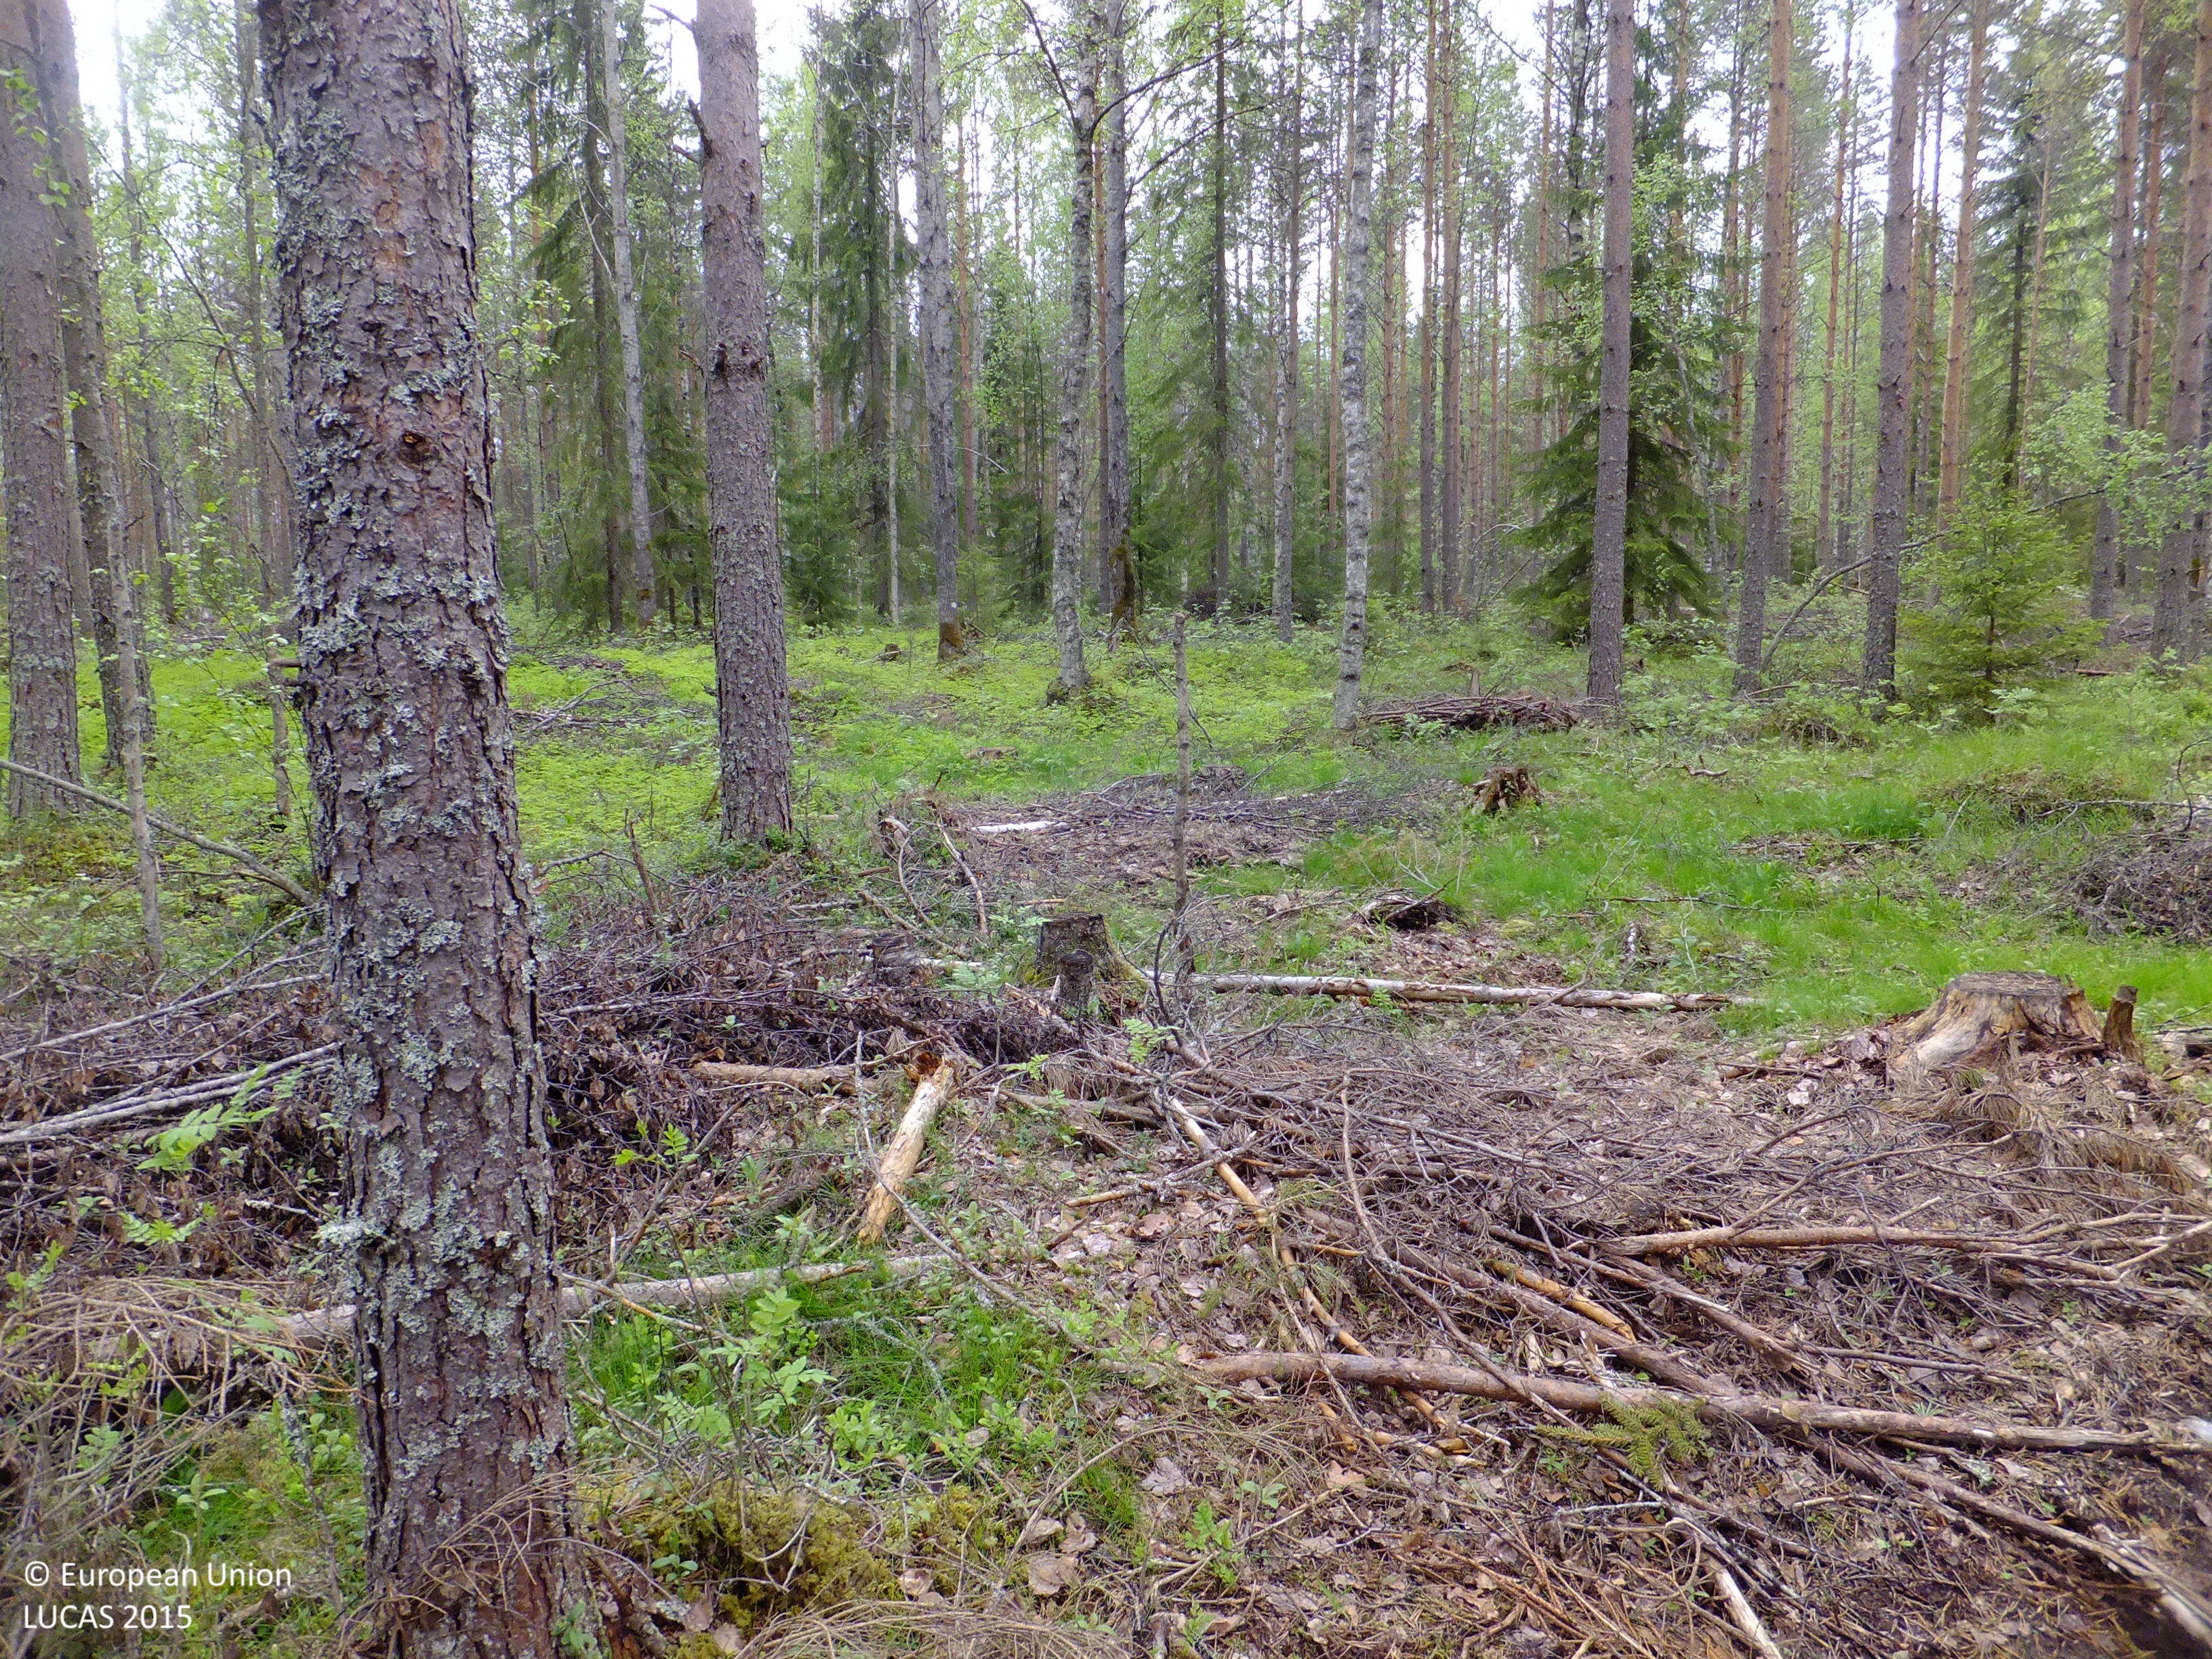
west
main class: Woodland
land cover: Pine dominated mixed woodland
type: boreal forest
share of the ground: > 75 %
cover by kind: coniferous forest trees 50 %, broadleaved forest trees 25 %, herbaceous plants 10 %, lichens and mosses 10 %, shrubs 5 %
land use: Forestry
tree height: > 5 m
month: June
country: FI
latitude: 63.4234
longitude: 23.1800
